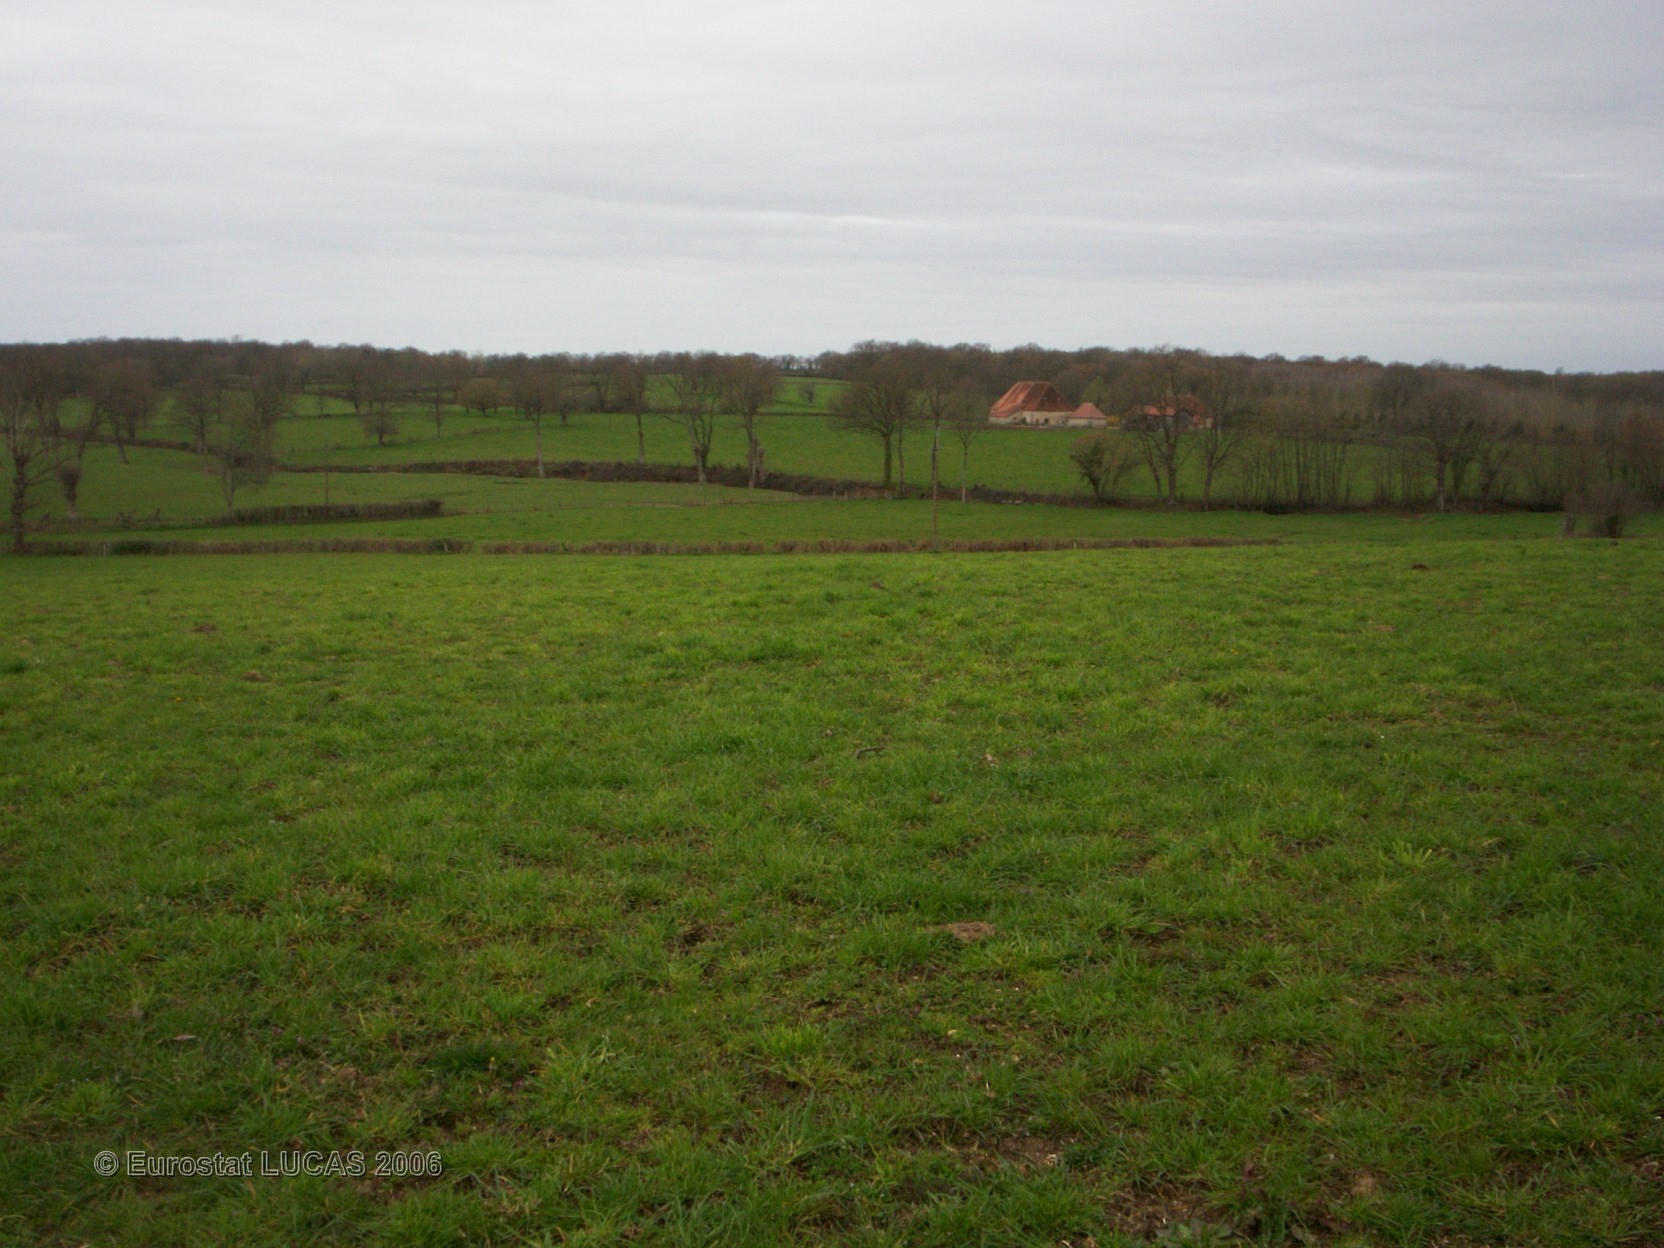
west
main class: Grassland
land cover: Grassland without tree/shrub cover
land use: Agriculture (excluding fallow land and kitchen gardens)
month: April
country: FR
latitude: 46.7085
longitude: 3.1299
